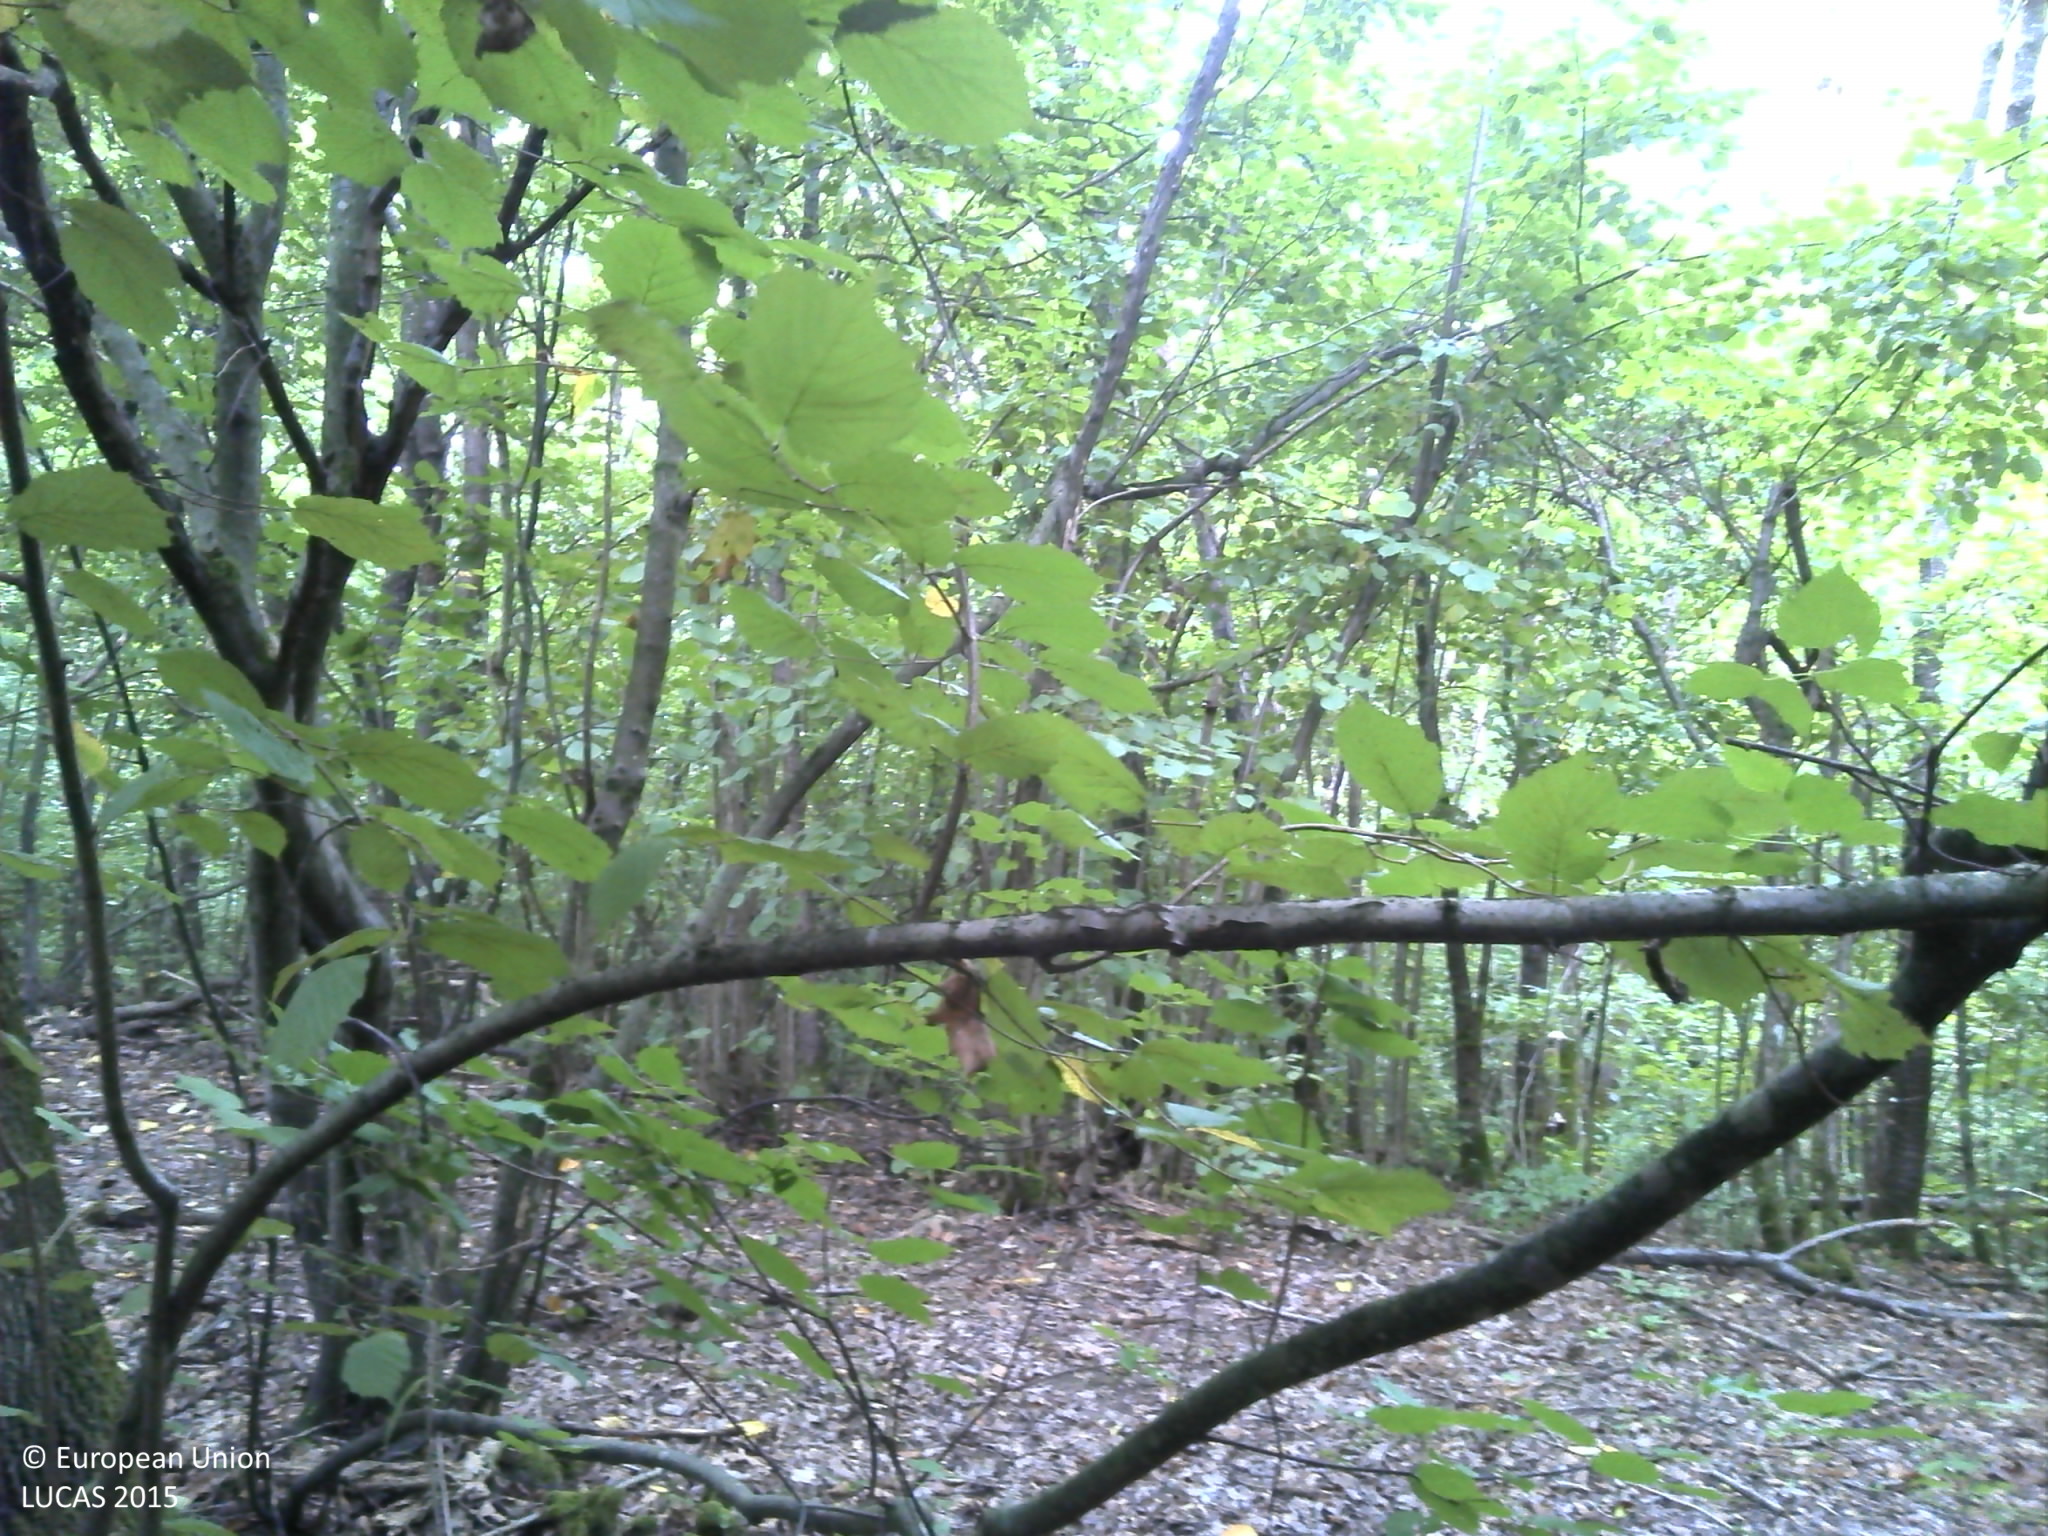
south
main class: Woodland
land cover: Broadleaved woodland
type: acidophilous oak and oak-birch forest
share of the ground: > 75 %
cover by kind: broadleaved forest trees 100 %
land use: Forestry
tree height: > 5 m
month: August
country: HR
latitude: 45.2234
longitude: 16.6328
